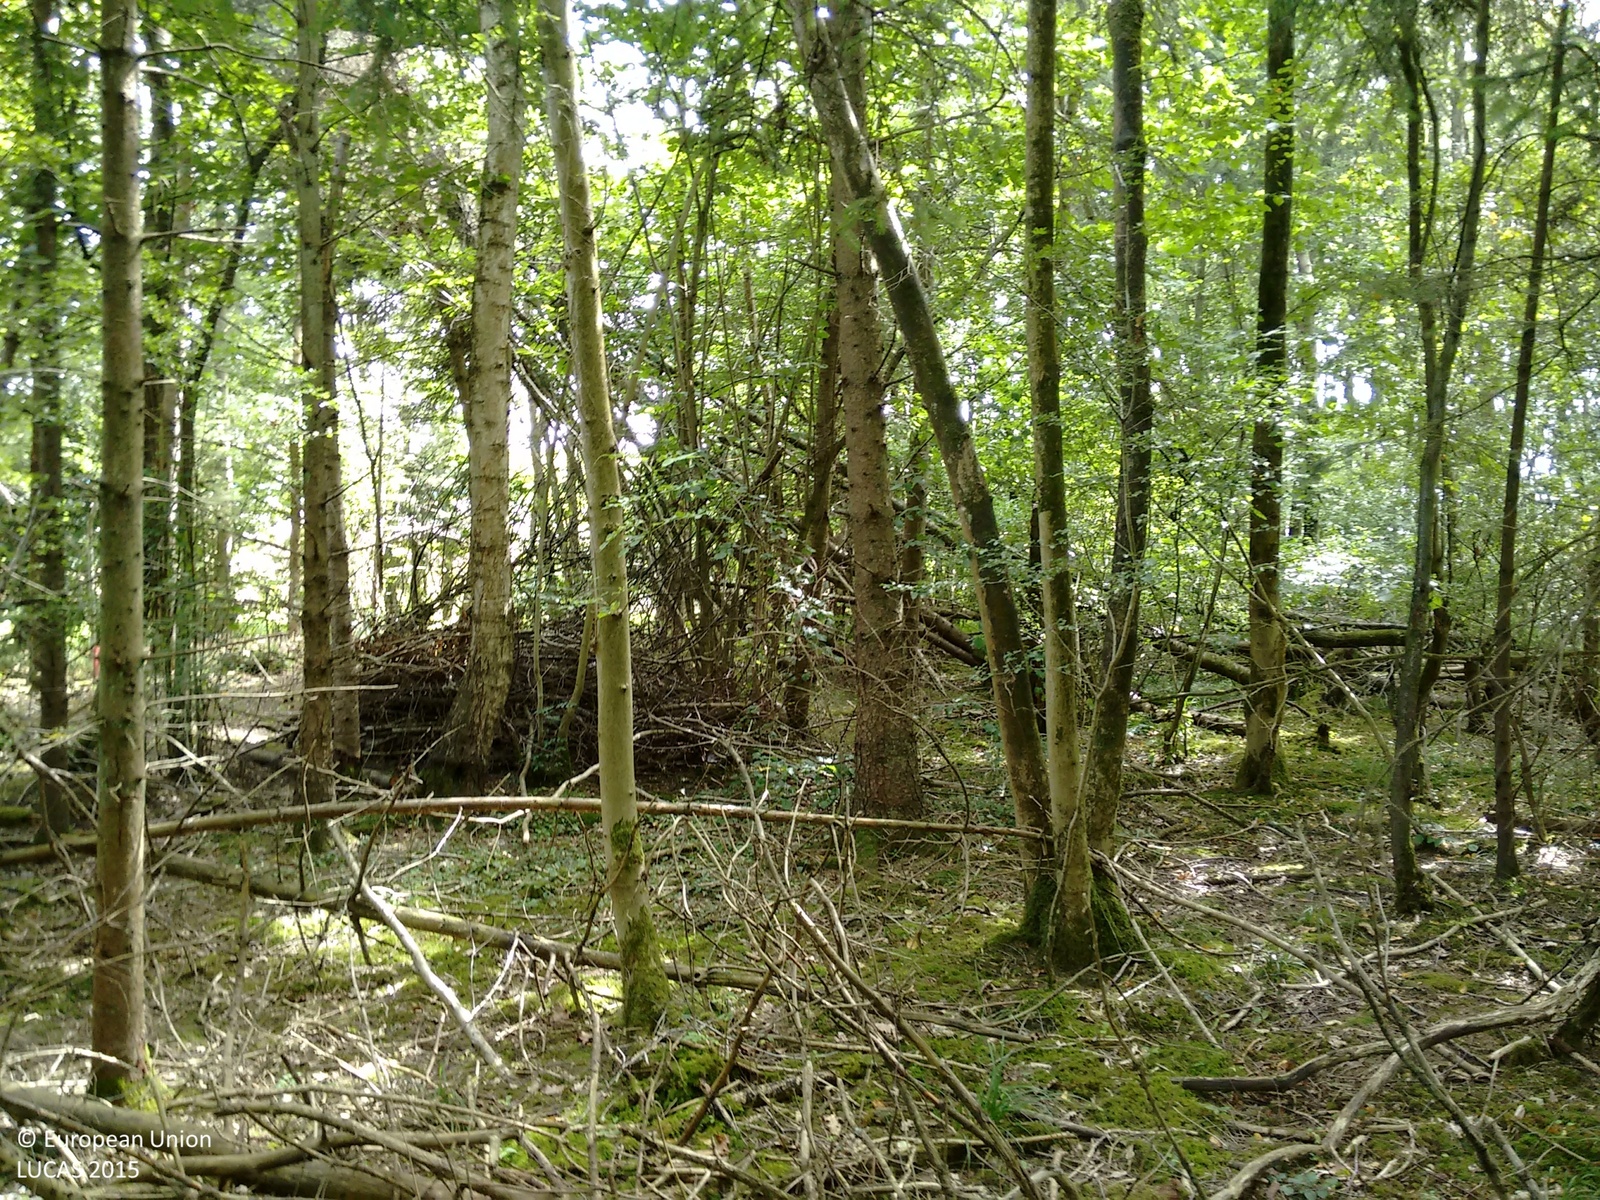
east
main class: Woodland
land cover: Spruce dominated mixed woodland
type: exotic forest
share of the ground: > 75 %
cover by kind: broadleaved forest trees 50 %, coniferous forest trees 40 %, shrubs 10 %
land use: Forestry
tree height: > 5 m
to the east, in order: Spruce dominated mixed woodland; Railways; Broadleaved woodland; Grassland without tree/shrub cover
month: August
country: GB
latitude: 51.2033
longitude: -0.2981
